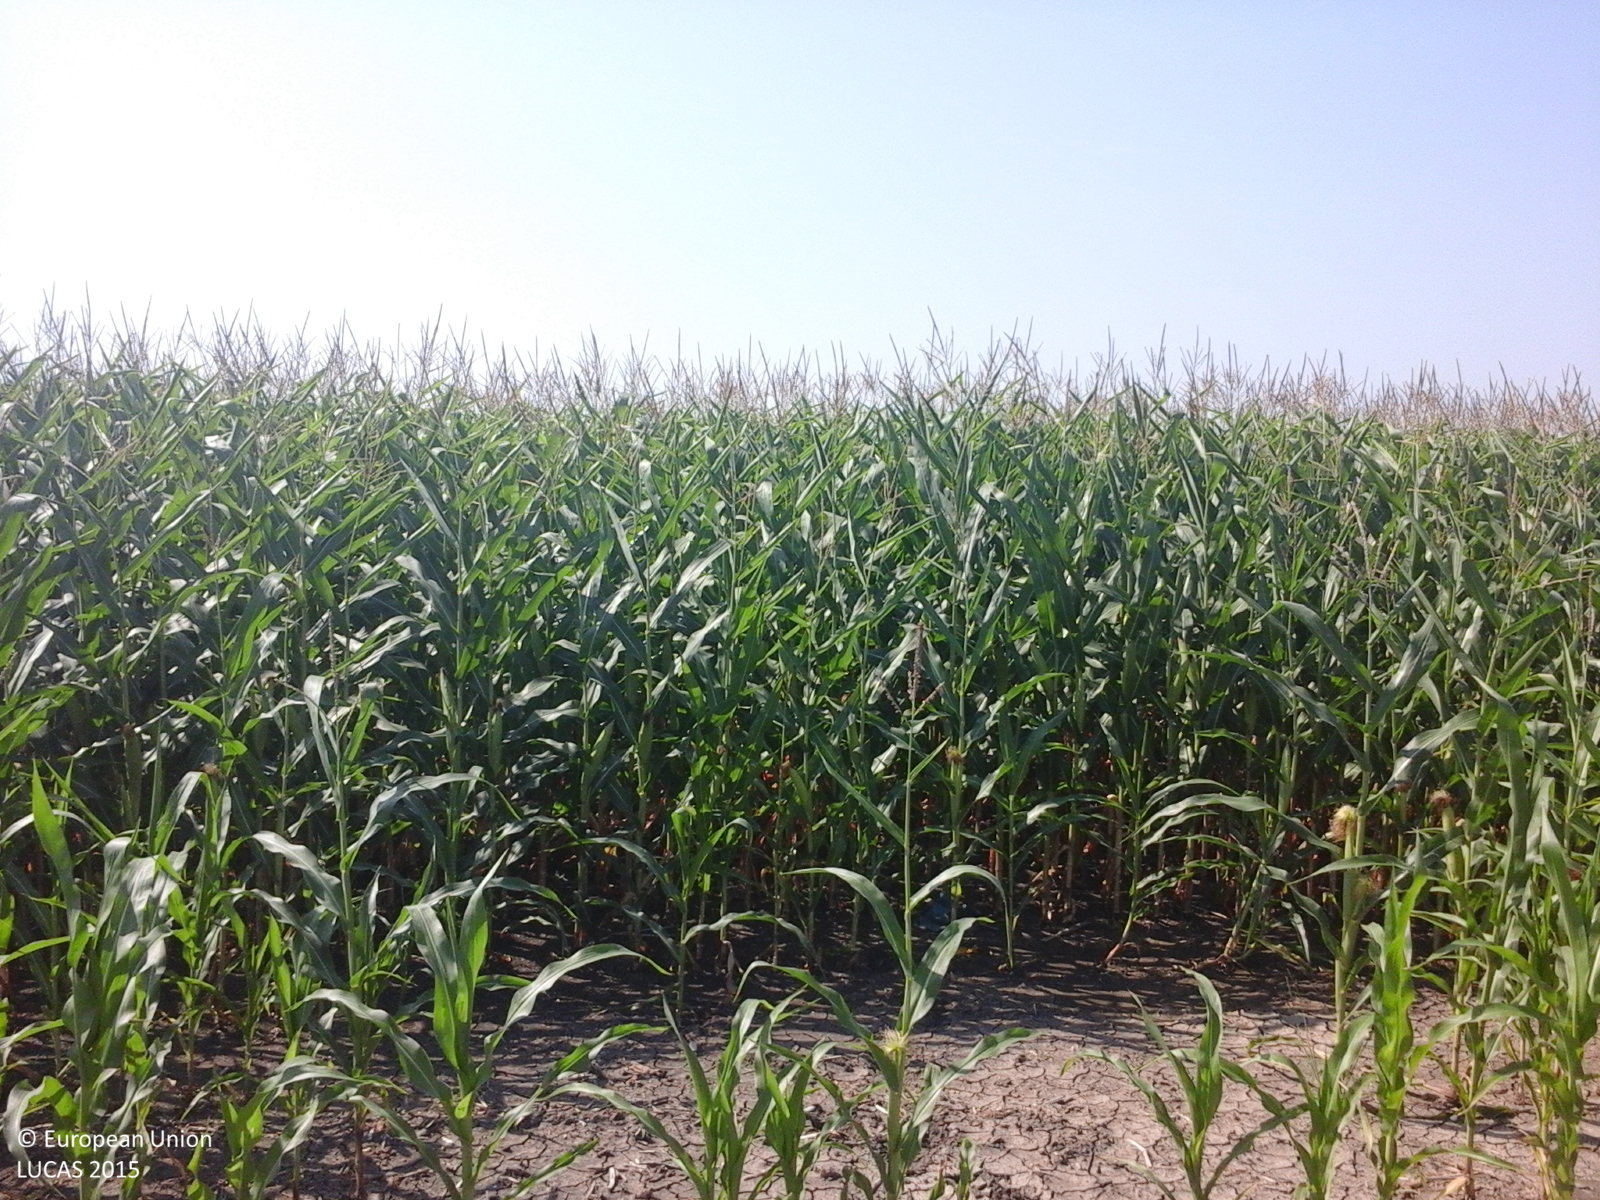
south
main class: Cropland
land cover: Maize
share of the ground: > 75 %
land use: Agriculture (excluding fallow land and kitchen gardens)
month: August
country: RO
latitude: 45.1690
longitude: 28.0430
